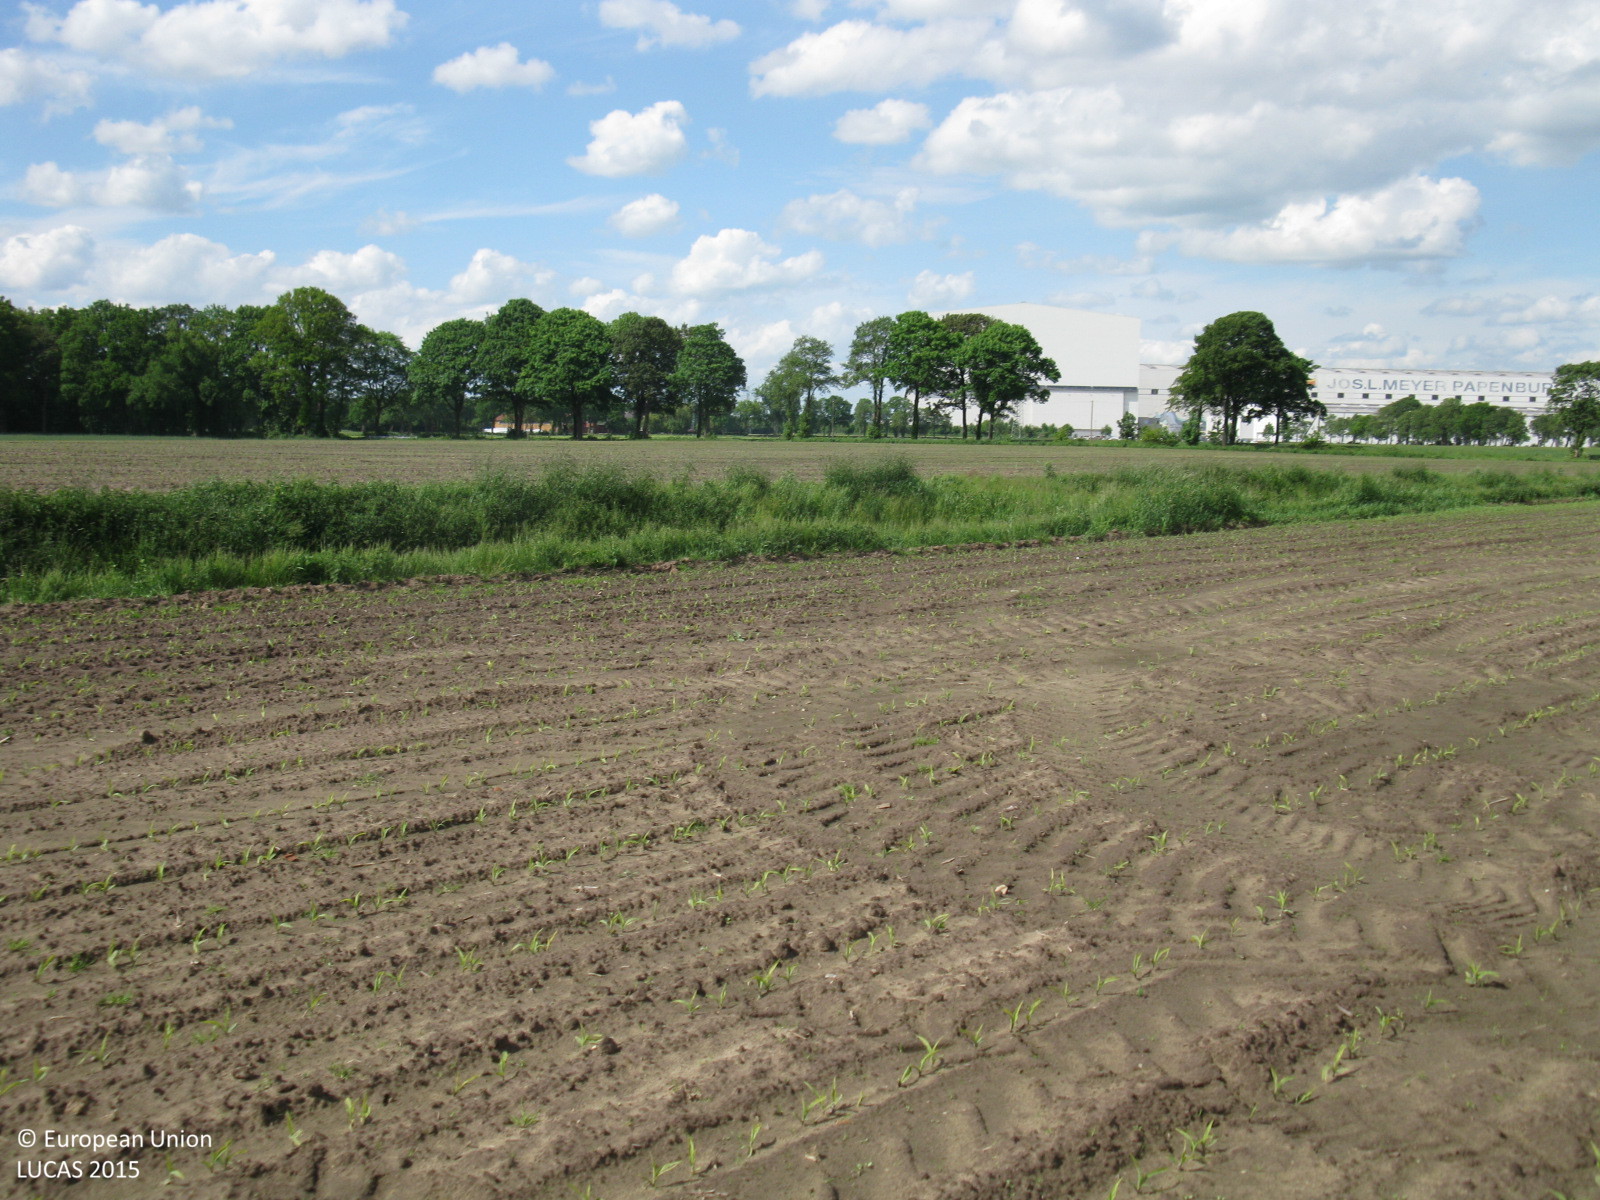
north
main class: Cropland
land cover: Maize
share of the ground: < 10 %
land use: Agriculture (excluding fallow land and kitchen gardens)
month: June
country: DE
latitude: 53.0854
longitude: 7.3579
